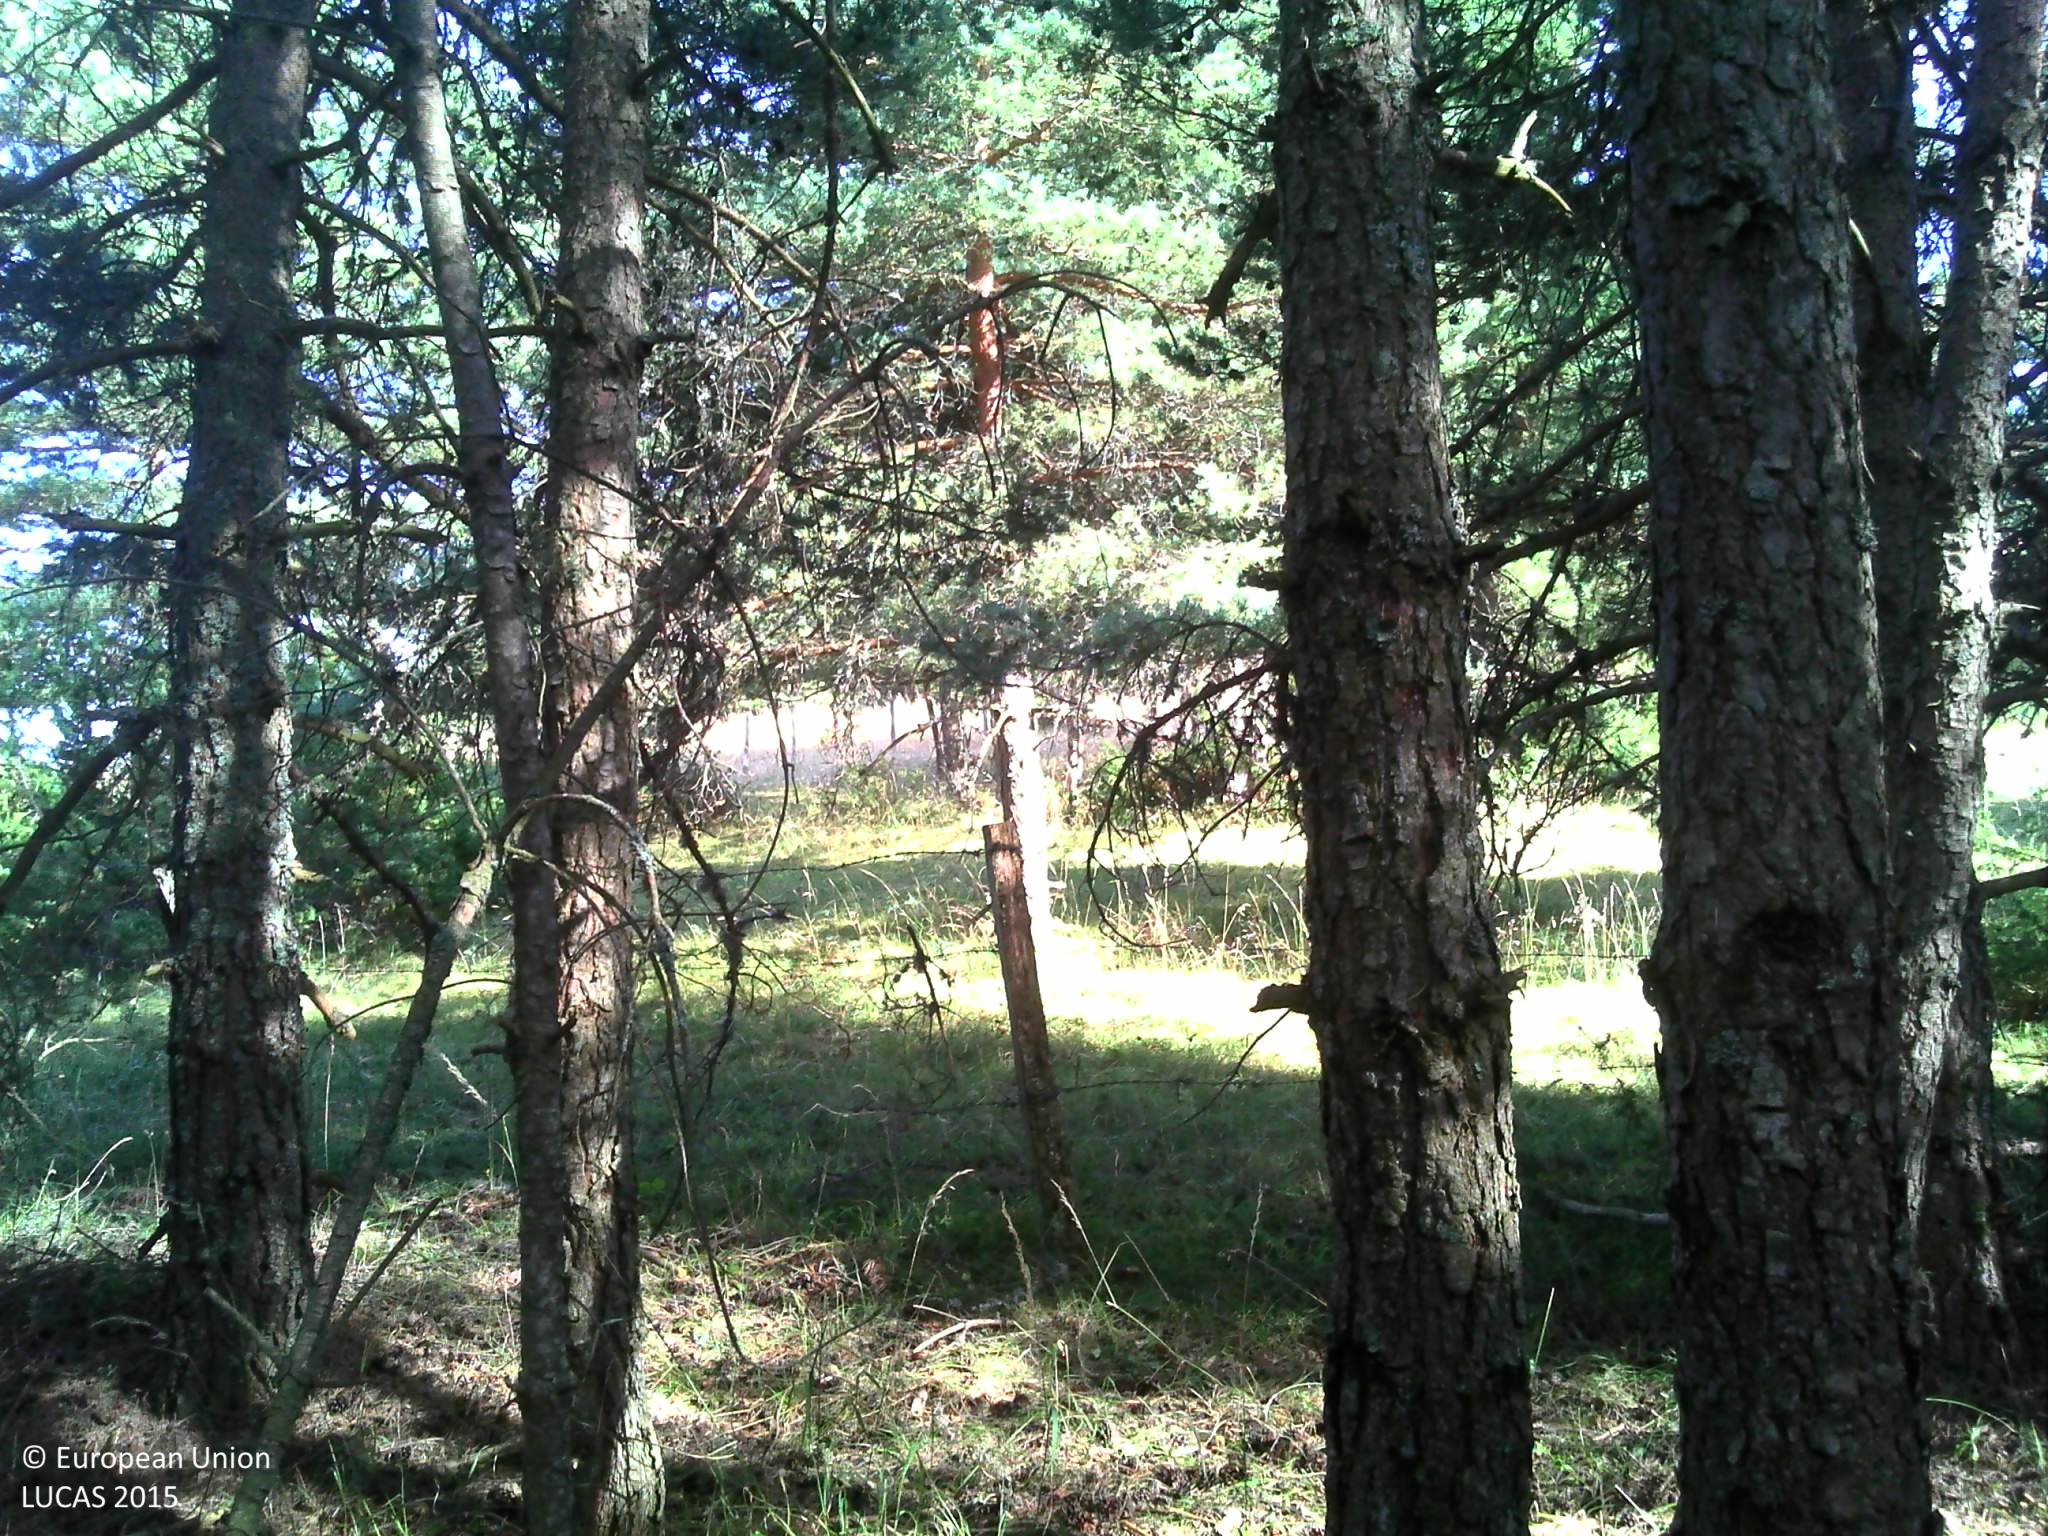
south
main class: Woodland
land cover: Pine dominated coniferous woodland
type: hemiboreal forest and nemoral coniferous forest and mixed broadleaved-coniferous forest
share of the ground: > 75 %
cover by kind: coniferous forest trees 95 %, broadleaved forest trees 5 %
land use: Forestry
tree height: > 5 m
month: July
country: FR
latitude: 44.5253
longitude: 3.1974
